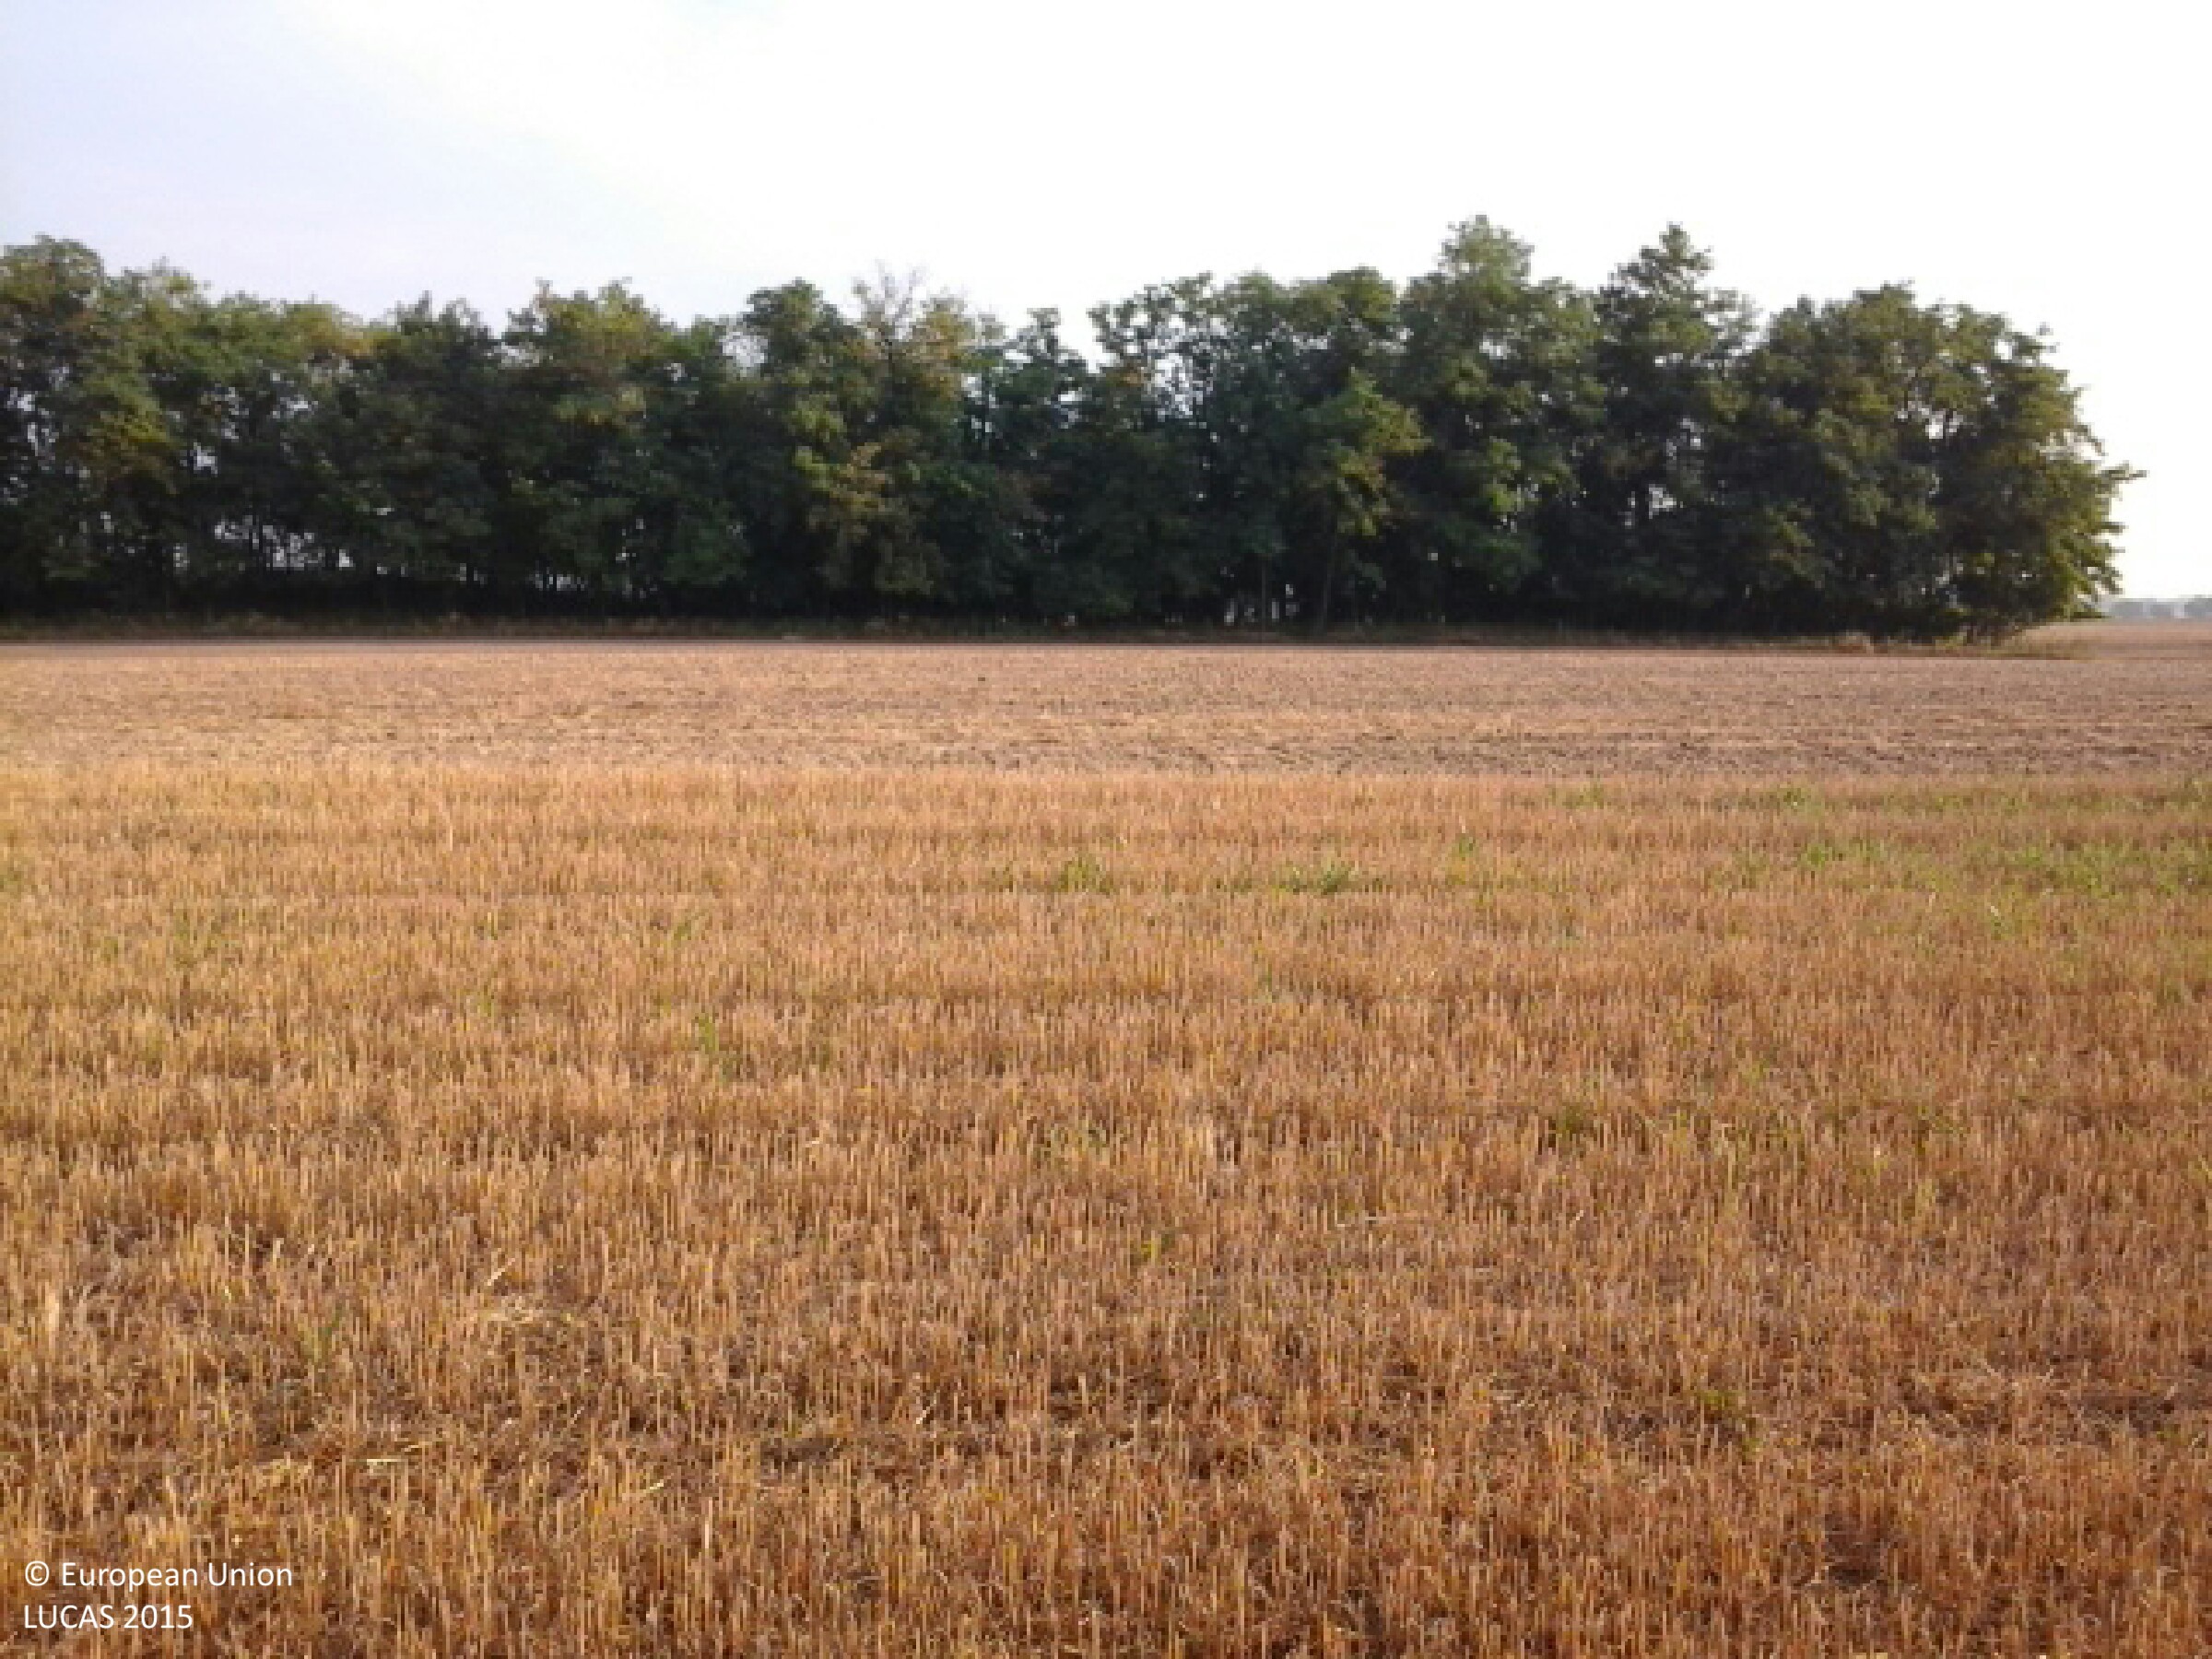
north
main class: Cropland
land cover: Triticale
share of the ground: 10 - 25 %
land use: Agriculture (excluding fallow land and kitchen gardens)
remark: Harvested field
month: August
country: HU
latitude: 47.7197
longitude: 17.9429
